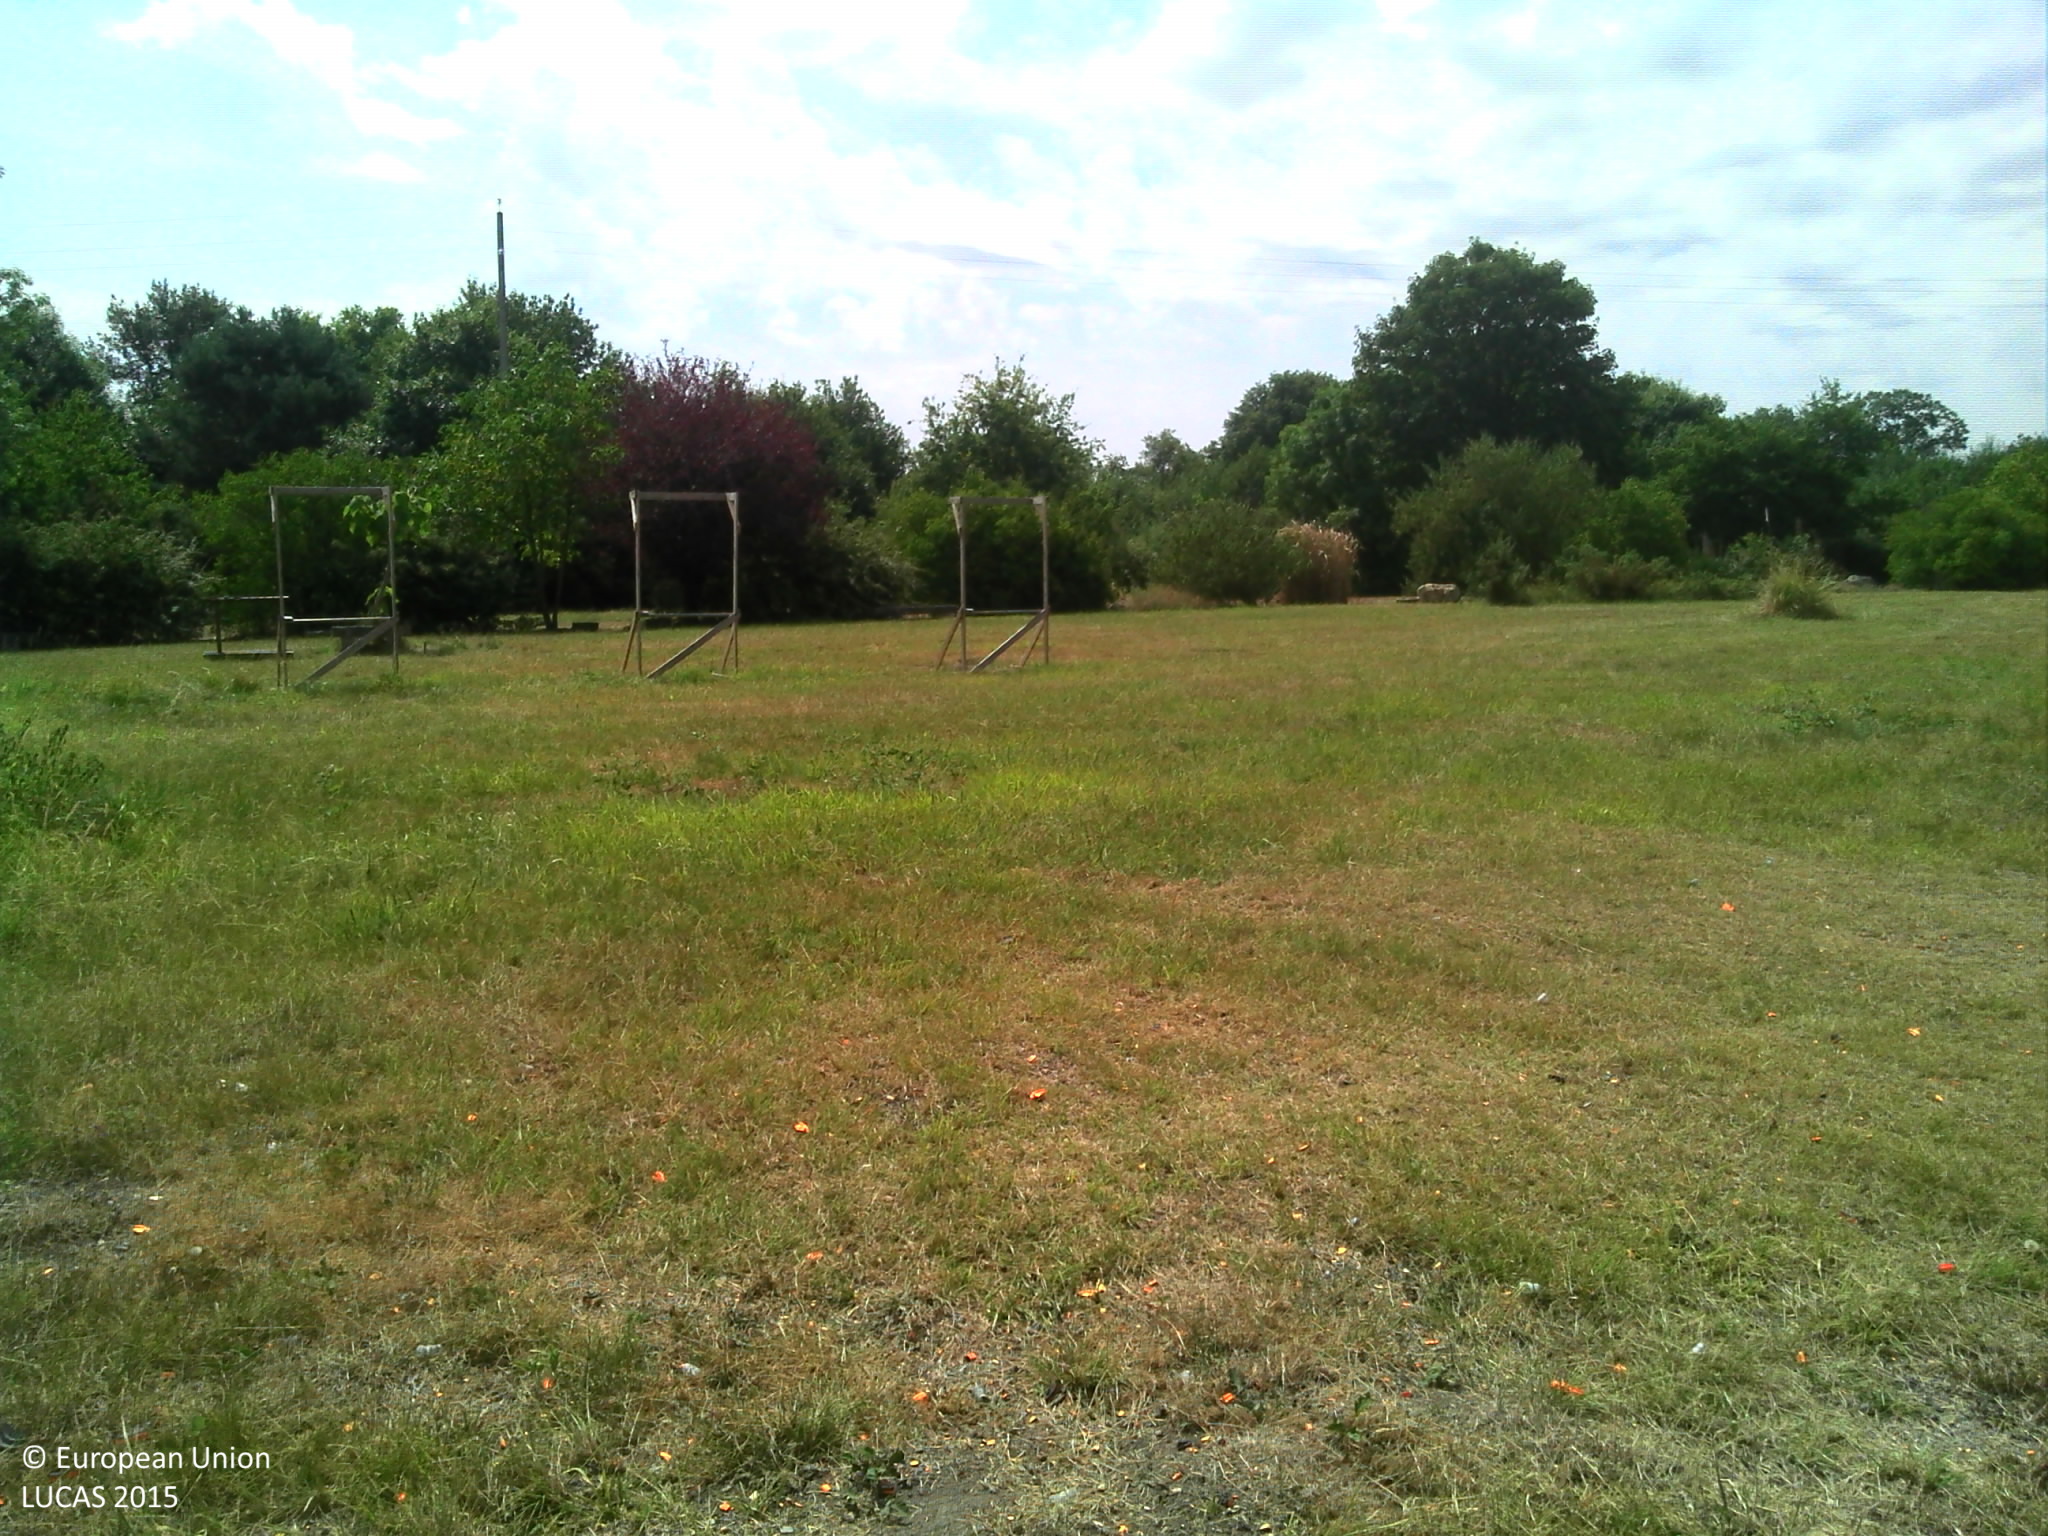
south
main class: Grassland
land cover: Grassland without tree/shrub cover
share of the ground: > 75 %
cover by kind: herbaceous plants 95 %, shrubs 5 %
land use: Sport
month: August
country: FR
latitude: 47.1495
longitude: 0.1785
